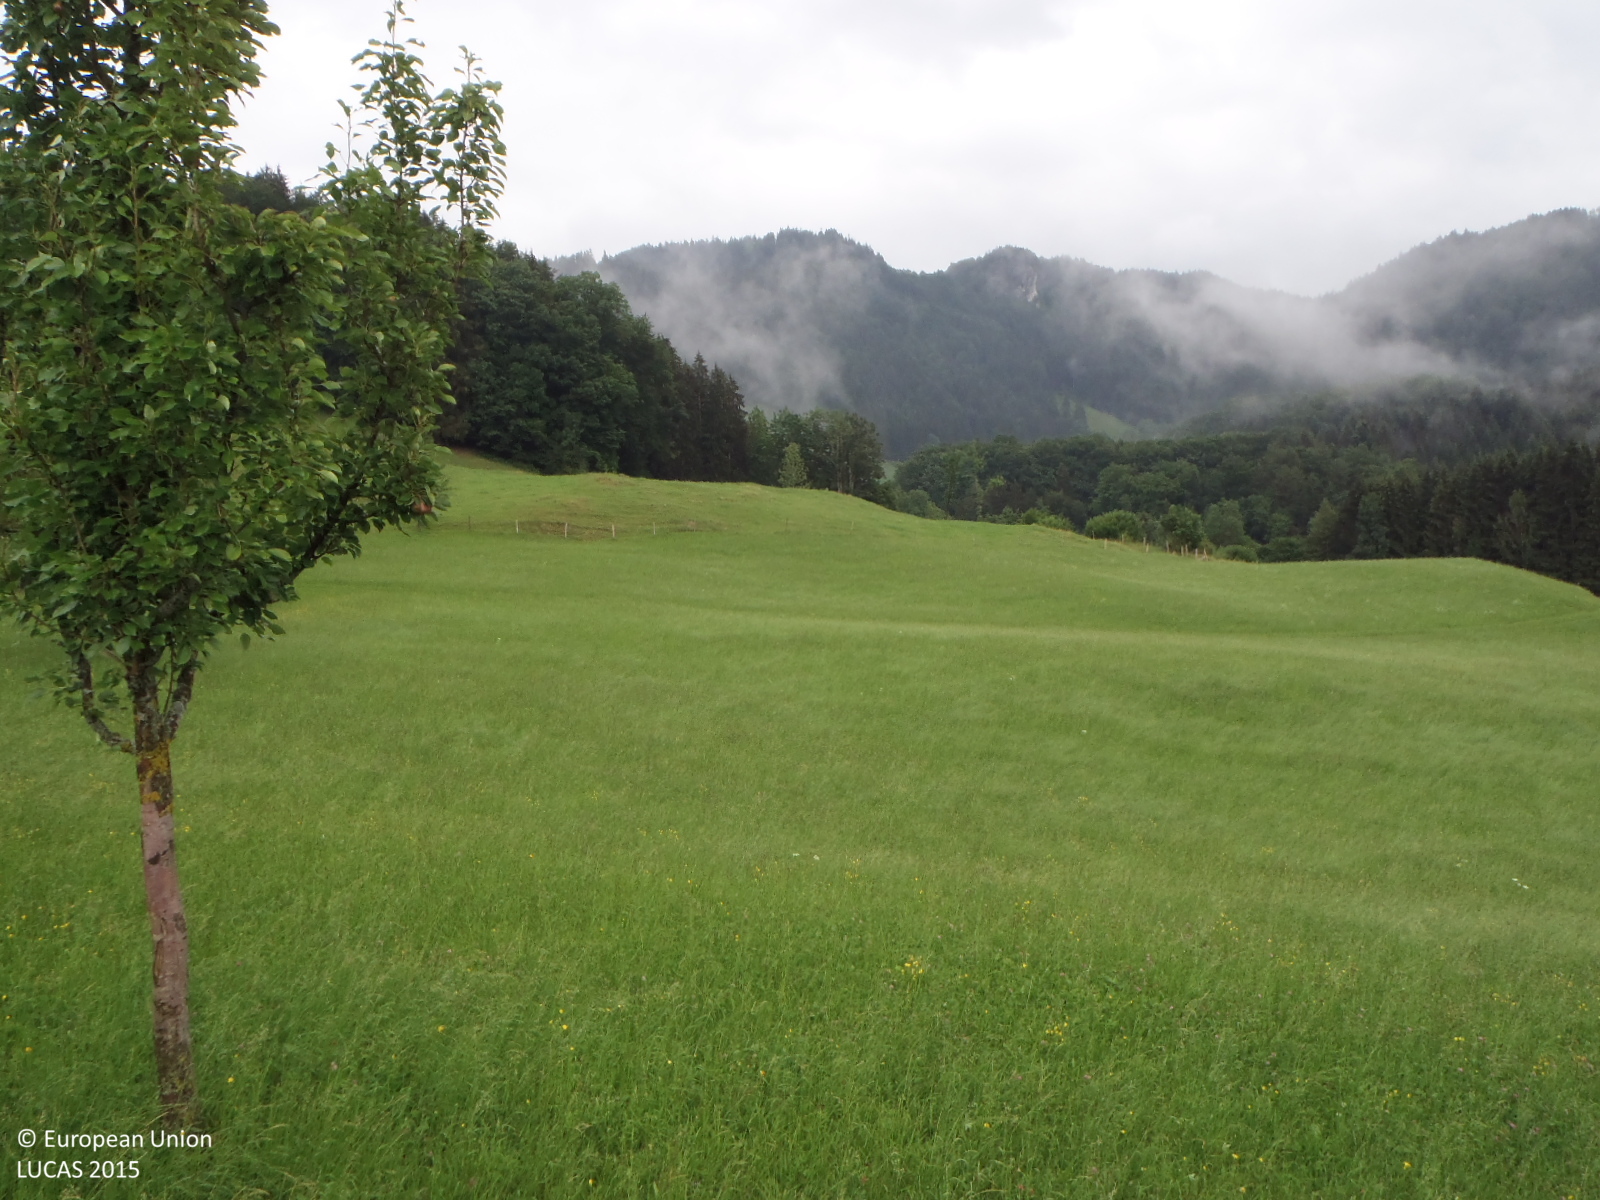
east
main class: Grassland
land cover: Grassland without tree/shrub cover
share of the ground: > 75 %
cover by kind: herbaceous plants 100 %
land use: Agriculture (excluding fallow land and kitchen gardens)
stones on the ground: < 10 %
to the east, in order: Grassland without tree/shrub cover; Tracks; Grassland without tree/shrub cover; Fences; Grassland without tree/shrub cover; Fences; Broadleaved woodland
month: July
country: AT
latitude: 47.6796
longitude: 12.1965
